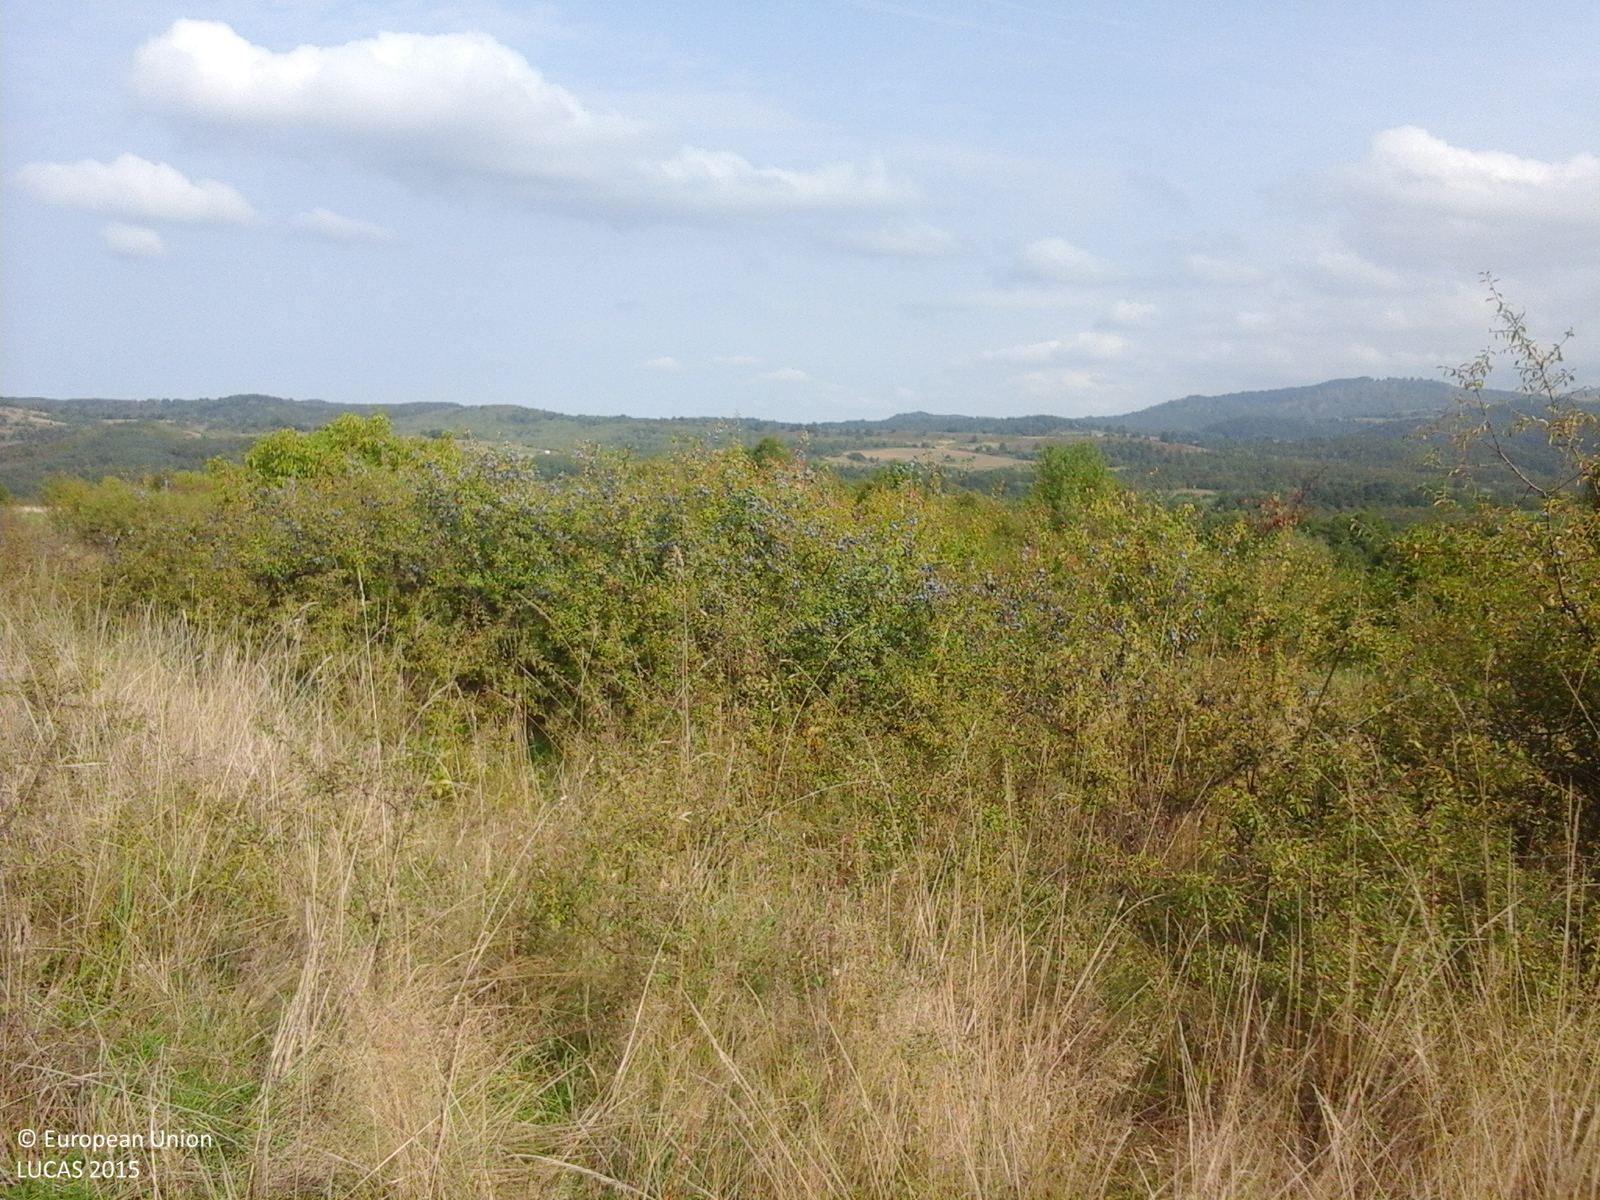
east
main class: Grassland
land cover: Grassland with sparse tree/shrub cover
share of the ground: > 75 %
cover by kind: herbaceous plants 85 %, shrubs 10 %, broadleaved forest trees 5 %
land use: Fallow land
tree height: < 5 m
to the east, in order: Grassland with sparse tree/shrub cover; Shrubland without tree cover; Grassland with sparse tree/shrub cover; Shrubland without tree cover; Grassland without tree/shrub cover; Shrubland without tree cover; Grassland without tree/shrub cover; Other fruit trees and berries; Broadleaved woodland; Other fruit trees and berries
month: September
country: RO
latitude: 45.8192
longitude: 22.3103
